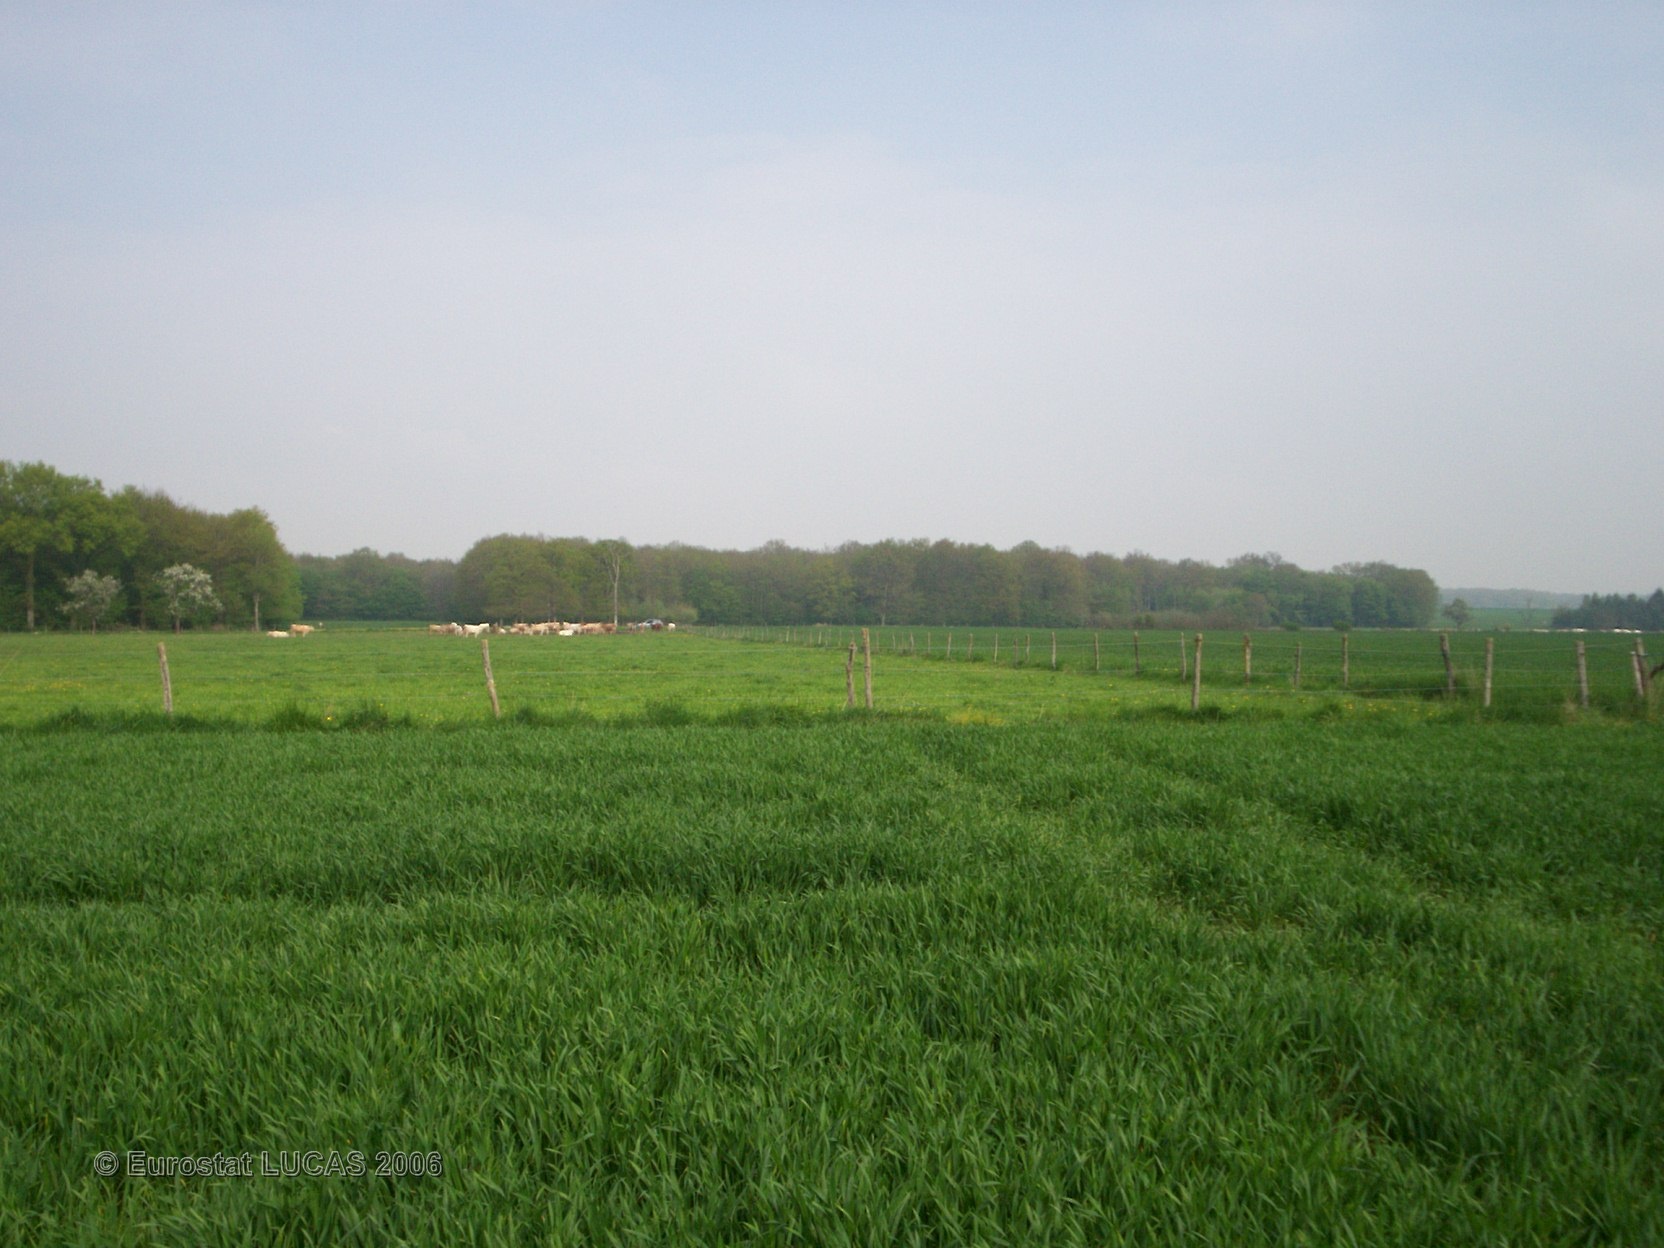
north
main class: Cropland
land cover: Common wheat
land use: Agriculture (excluding fallow land and kitchen gardens)
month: April
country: FR
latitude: 47.9930
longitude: 2.8766
